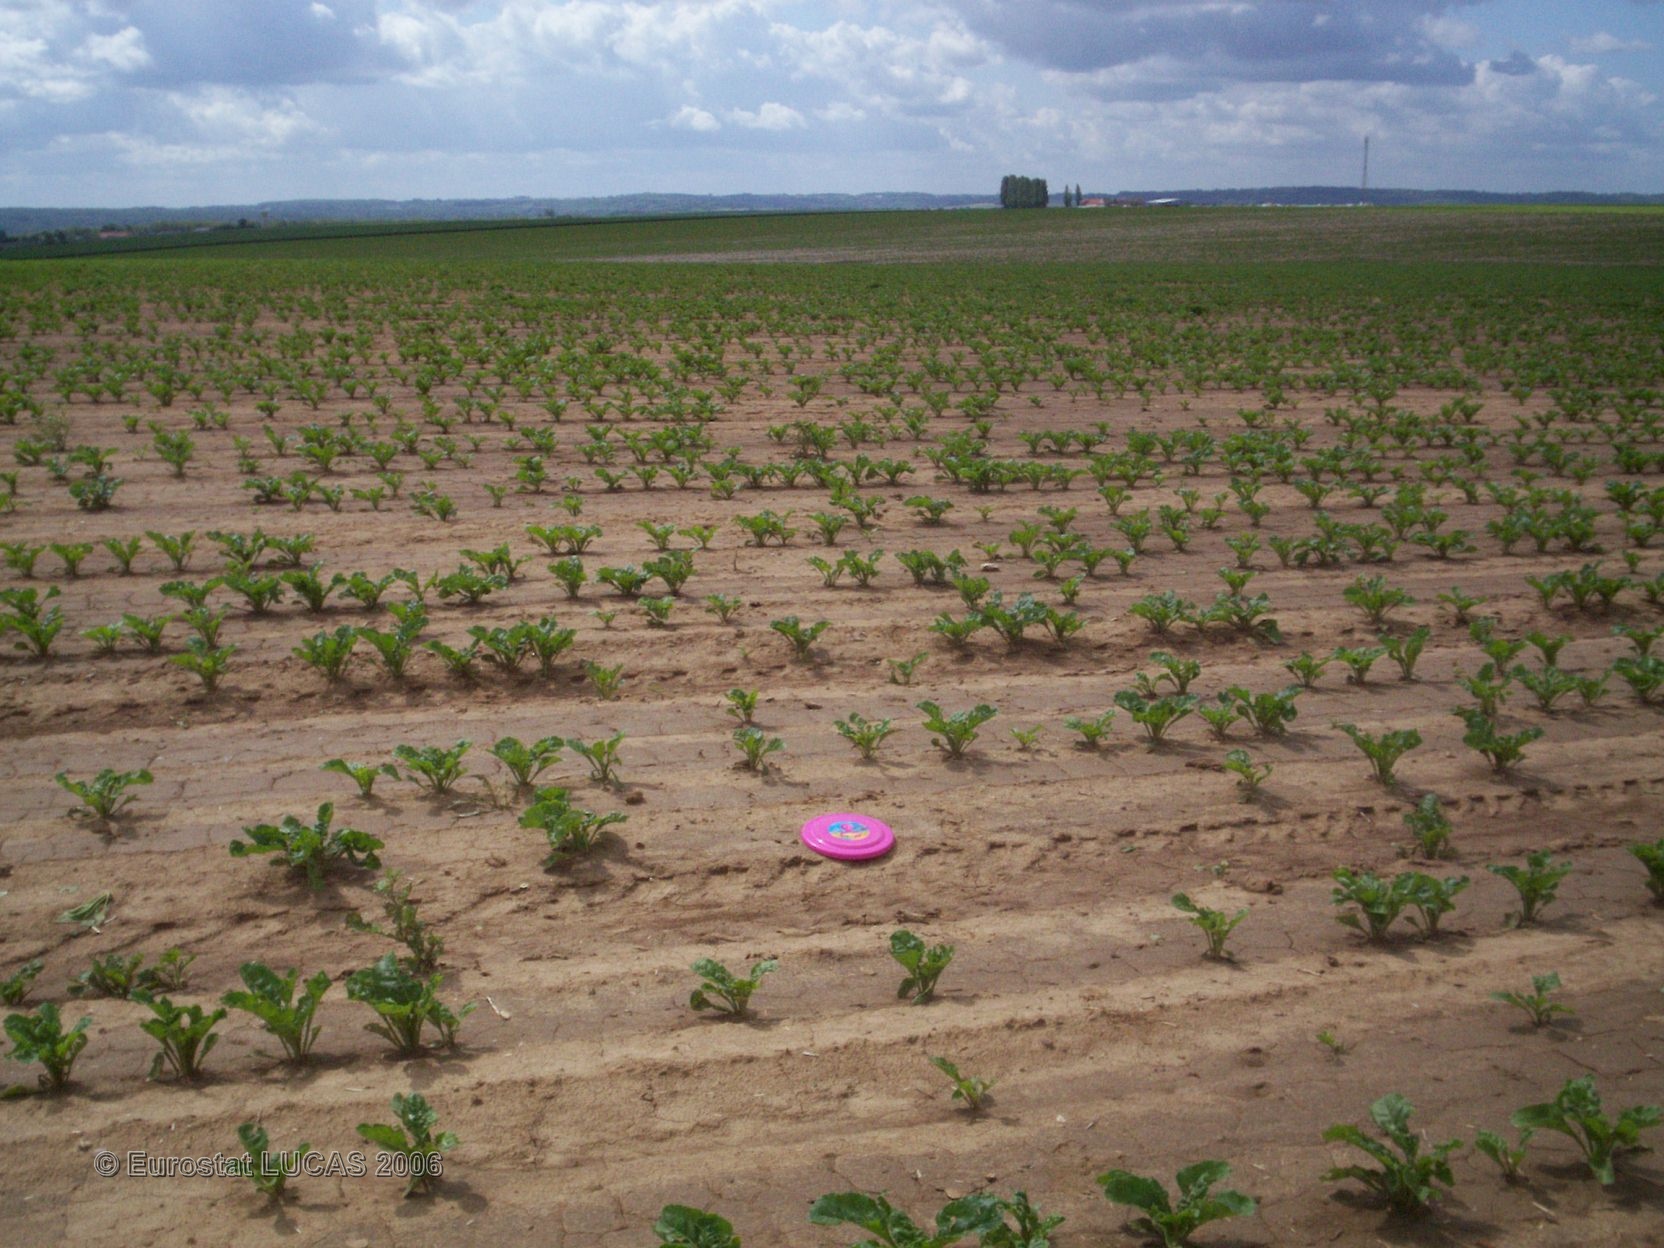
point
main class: Cropland
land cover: Sugar beet
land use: Agriculture (excluding fallow land and kitchen gardens)
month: May
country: FR
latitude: 48.9611
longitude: 2.7648
